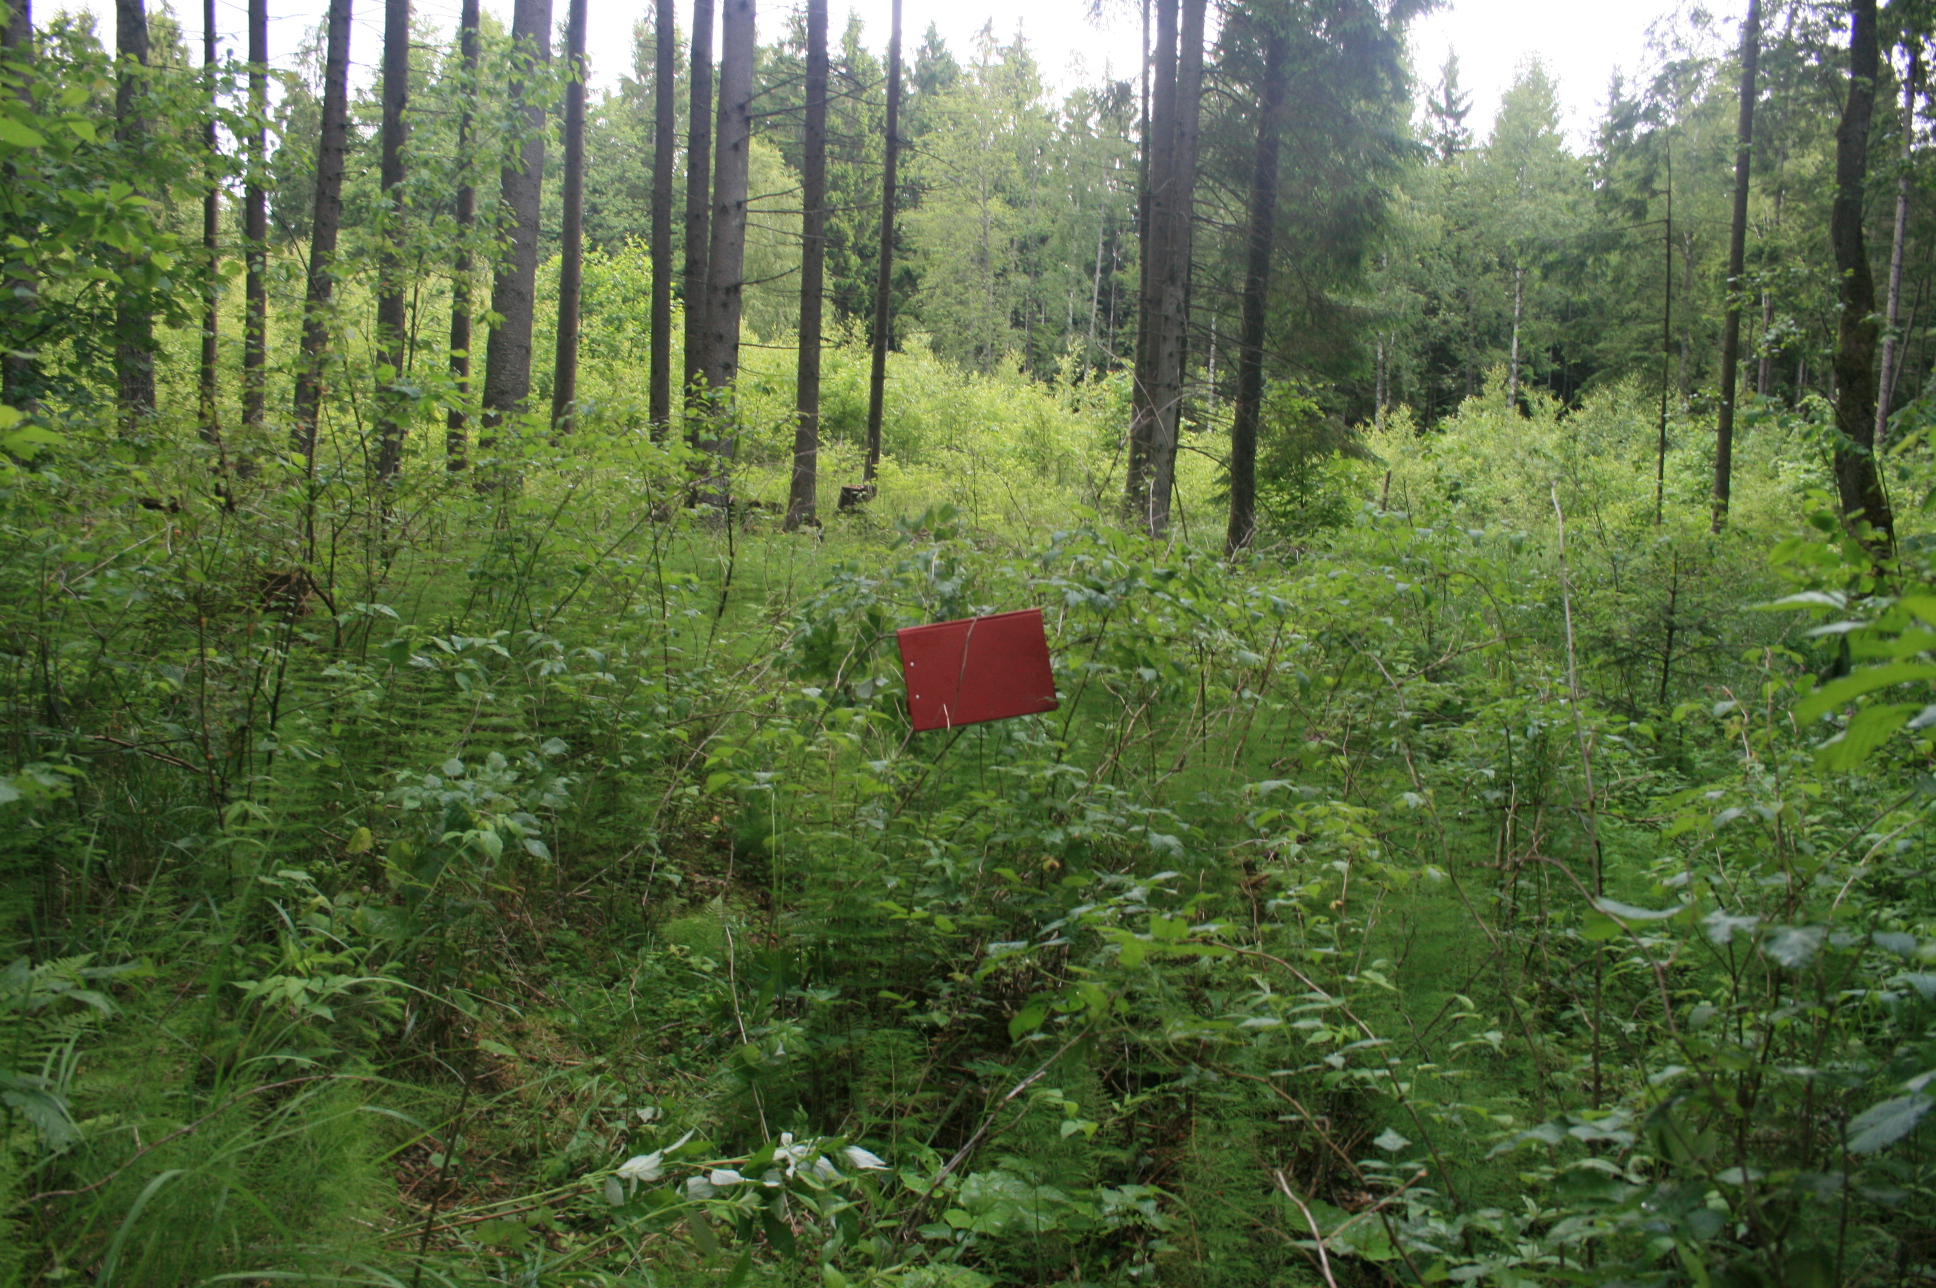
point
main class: Woodland
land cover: Spruce dominated mixed woodland
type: hemiboreal forest and nemoral coniferous forest and mixed broadleaved-coniferous forest
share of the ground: 50 - 75 %
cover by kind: coniferous forest trees 50 %, herbaceous plants 30 %, broadleaved forest trees 20 %
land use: Forestry
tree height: > 5 m
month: June
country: LT
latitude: 55.3527
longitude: 22.1529
